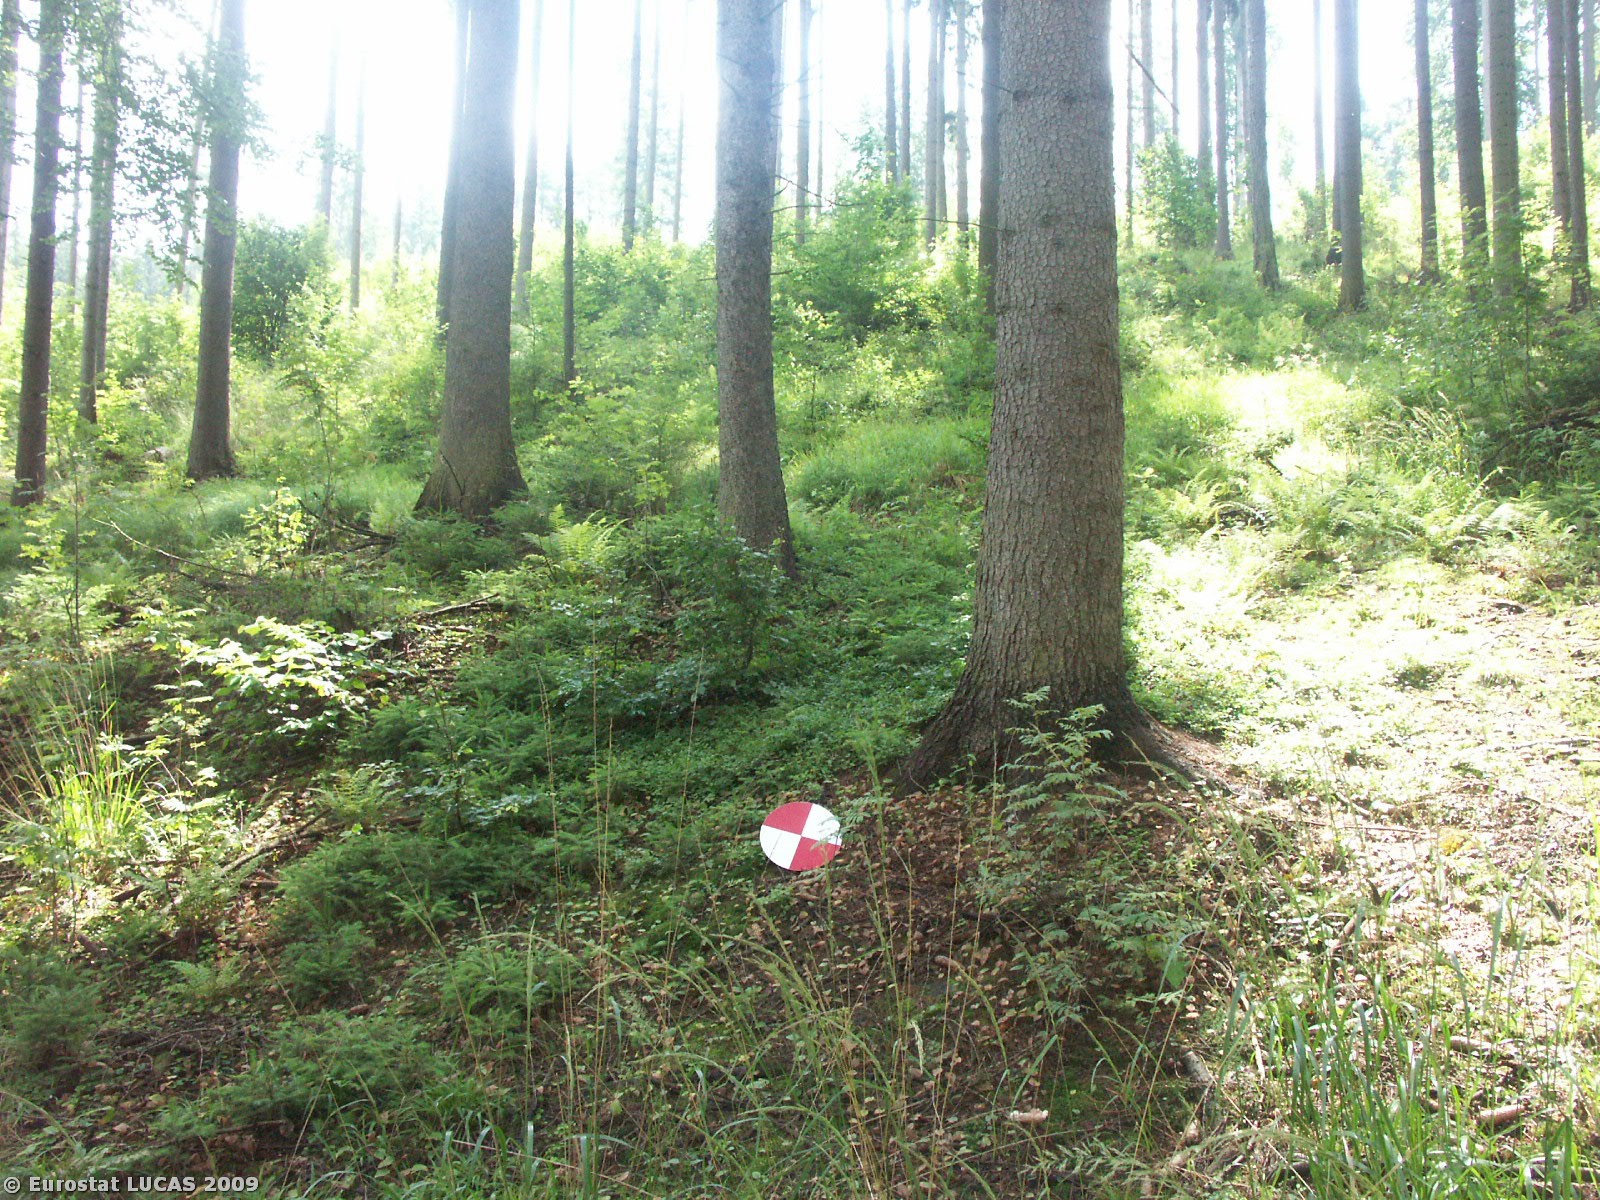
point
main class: Woodland
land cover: Coniferous woodland
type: hemiboreal forest and nemoral coniferous forest and mixed broadleaved-coniferous forest
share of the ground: > 75 %
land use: Forestry
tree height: > 5 m
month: July
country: CZ
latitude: 49.9429
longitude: 17.4111
